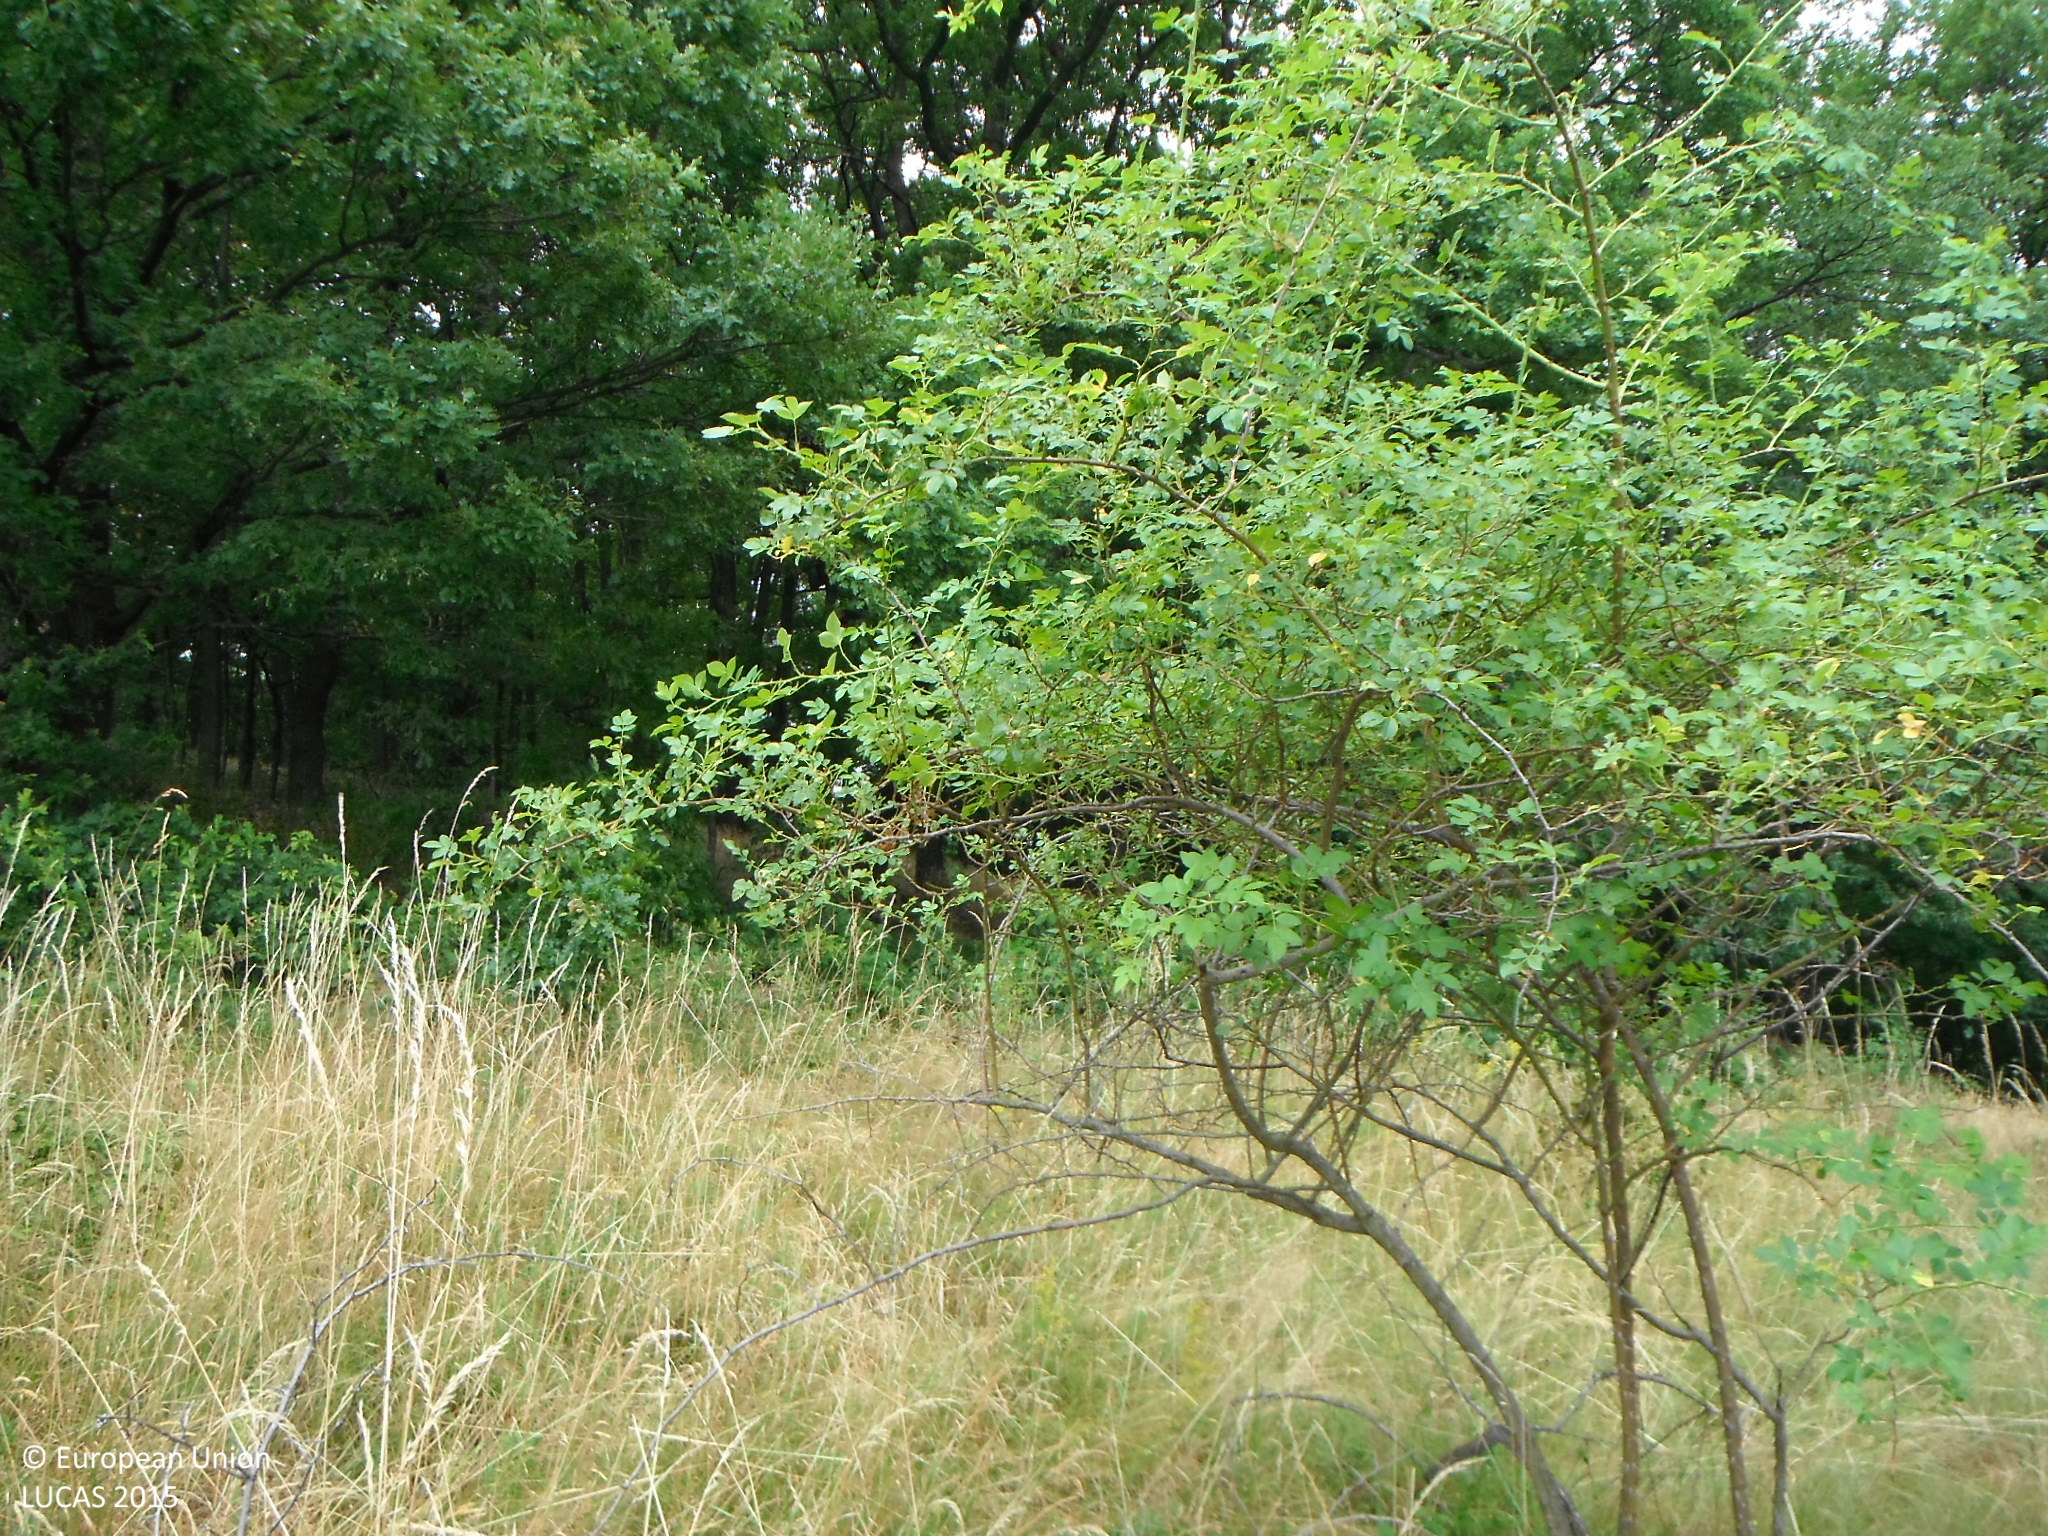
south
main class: Shrubland
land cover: Shrubland with sparse tree cover
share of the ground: > 75 %
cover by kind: shrubs 80 %, herbaceous plants 15 %, broadleaved forest trees 5 %
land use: Semi-natural and natural areas not in use
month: July
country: SK
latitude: 48.3799
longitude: 18.9990
